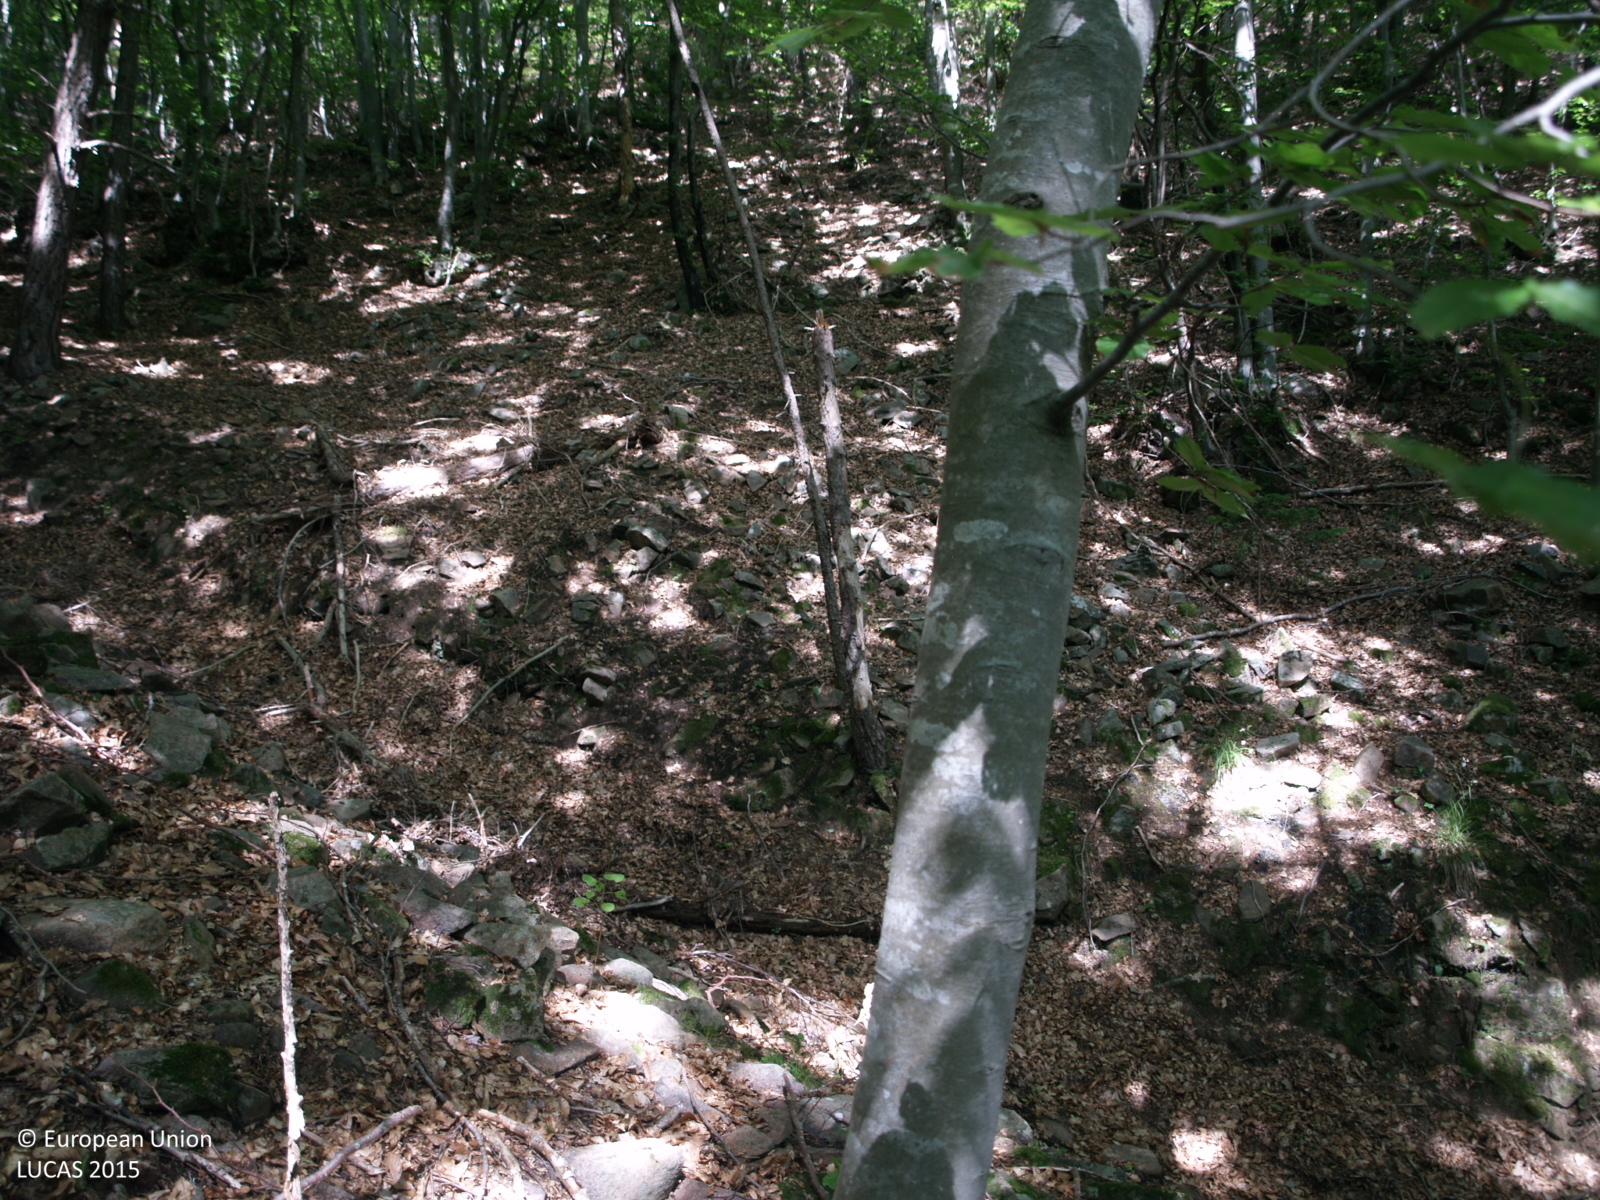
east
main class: Woodland
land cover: Broadleaved woodland
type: mesophytic deciduous forest
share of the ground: > 75 %
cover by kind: broadleaved forest trees 100 %
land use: Forestry
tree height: > 5 m
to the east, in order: Broadleaved woodland; Rivers and streams; Broadleaved woodland
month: May
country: IT
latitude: 45.8214
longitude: 11.2466
